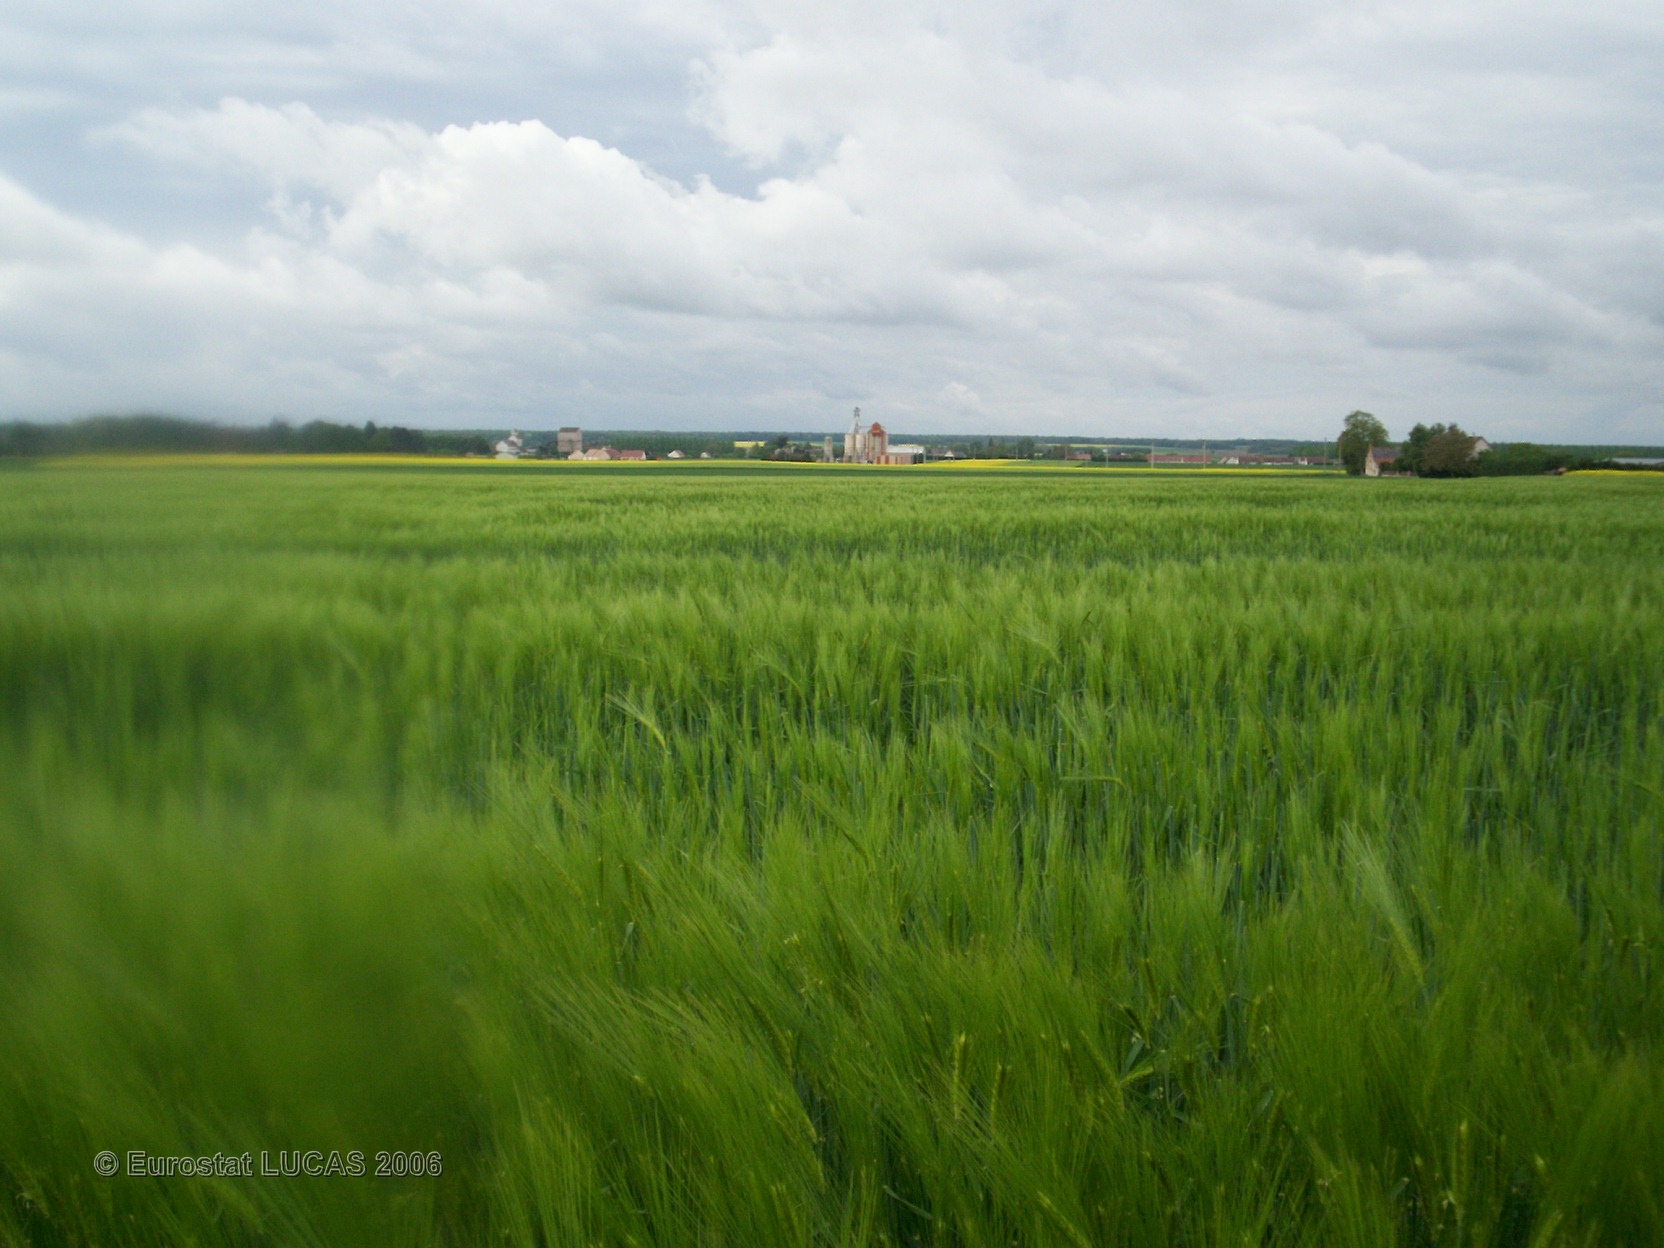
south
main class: Cropland
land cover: Barley
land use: Agriculture (excluding fallow land and kitchen gardens)
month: May
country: FR
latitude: 47.4047
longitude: 1.2522
